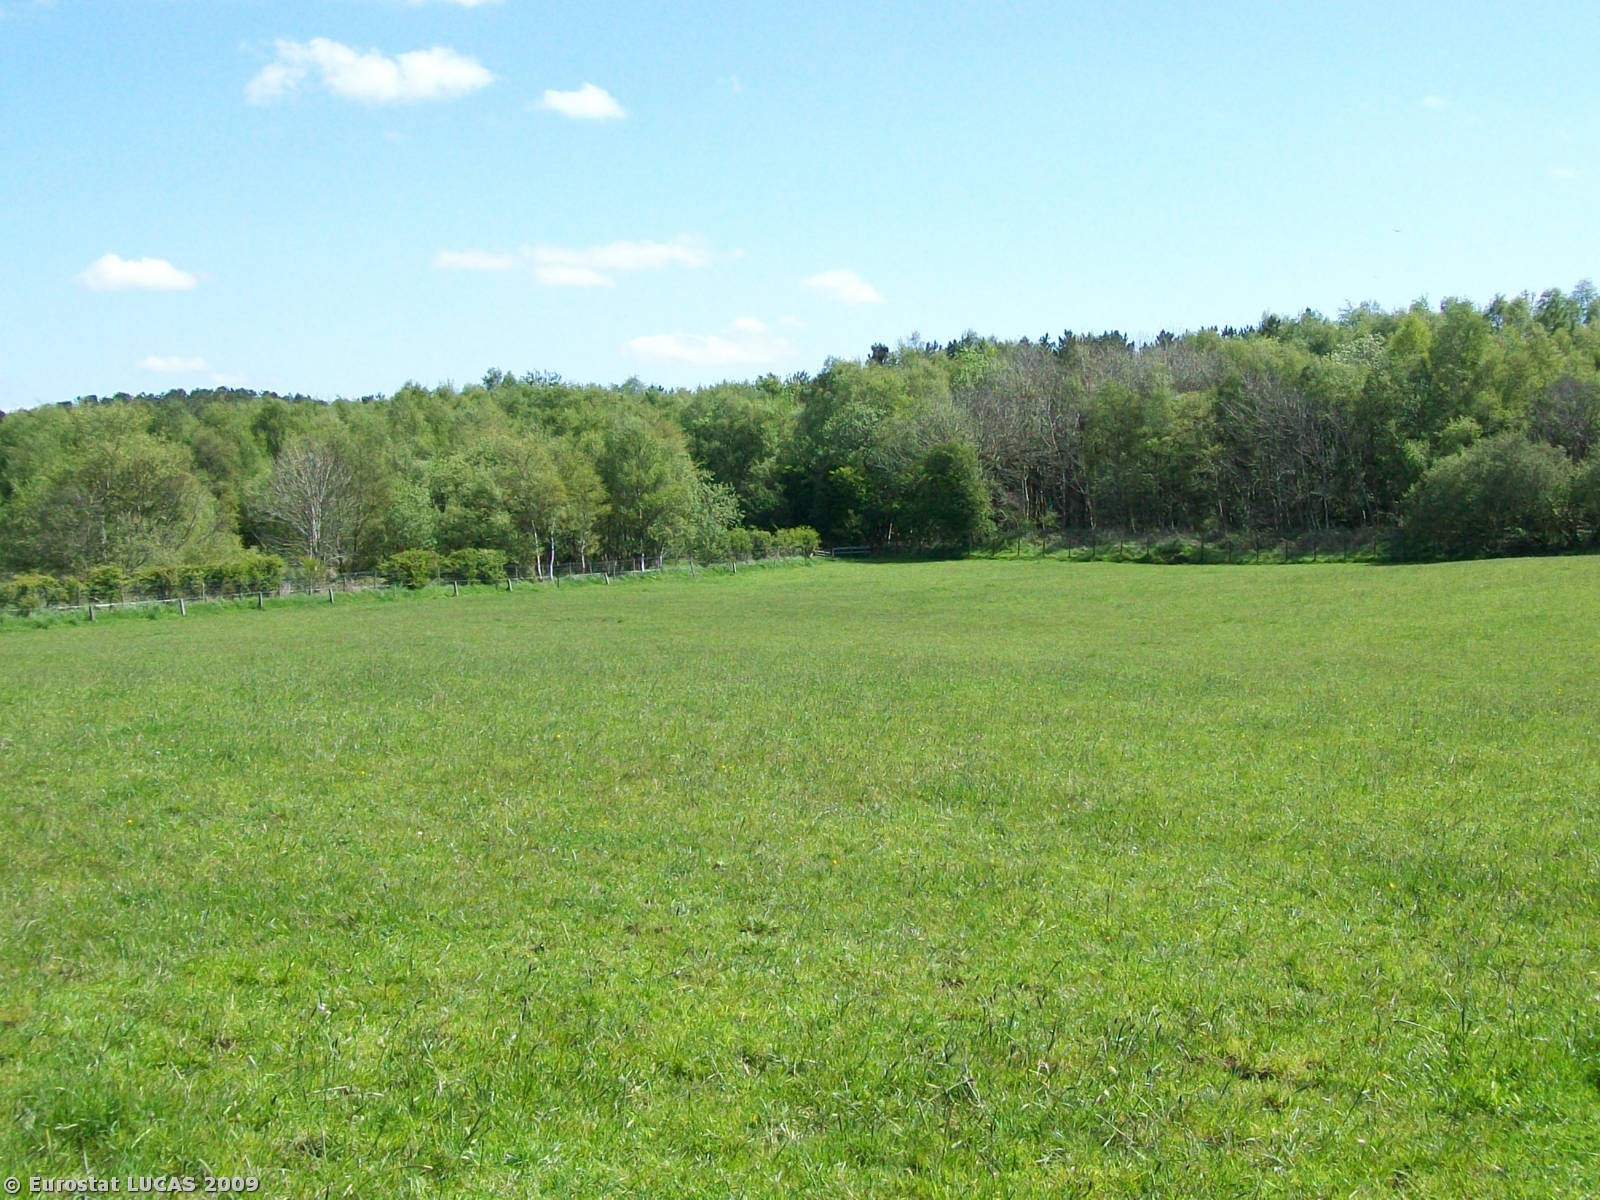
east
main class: Grassland
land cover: Grassland without tree/shrub cover
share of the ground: > 75 %
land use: Agriculture (excluding fallow land and kitchen gardens)
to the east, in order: Grassland without tree/shrub cover; Fences; Broadleaved woodland; Ditches and canals; Coniferous woodland
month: May
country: GB
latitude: 54.7788
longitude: -3.3084
